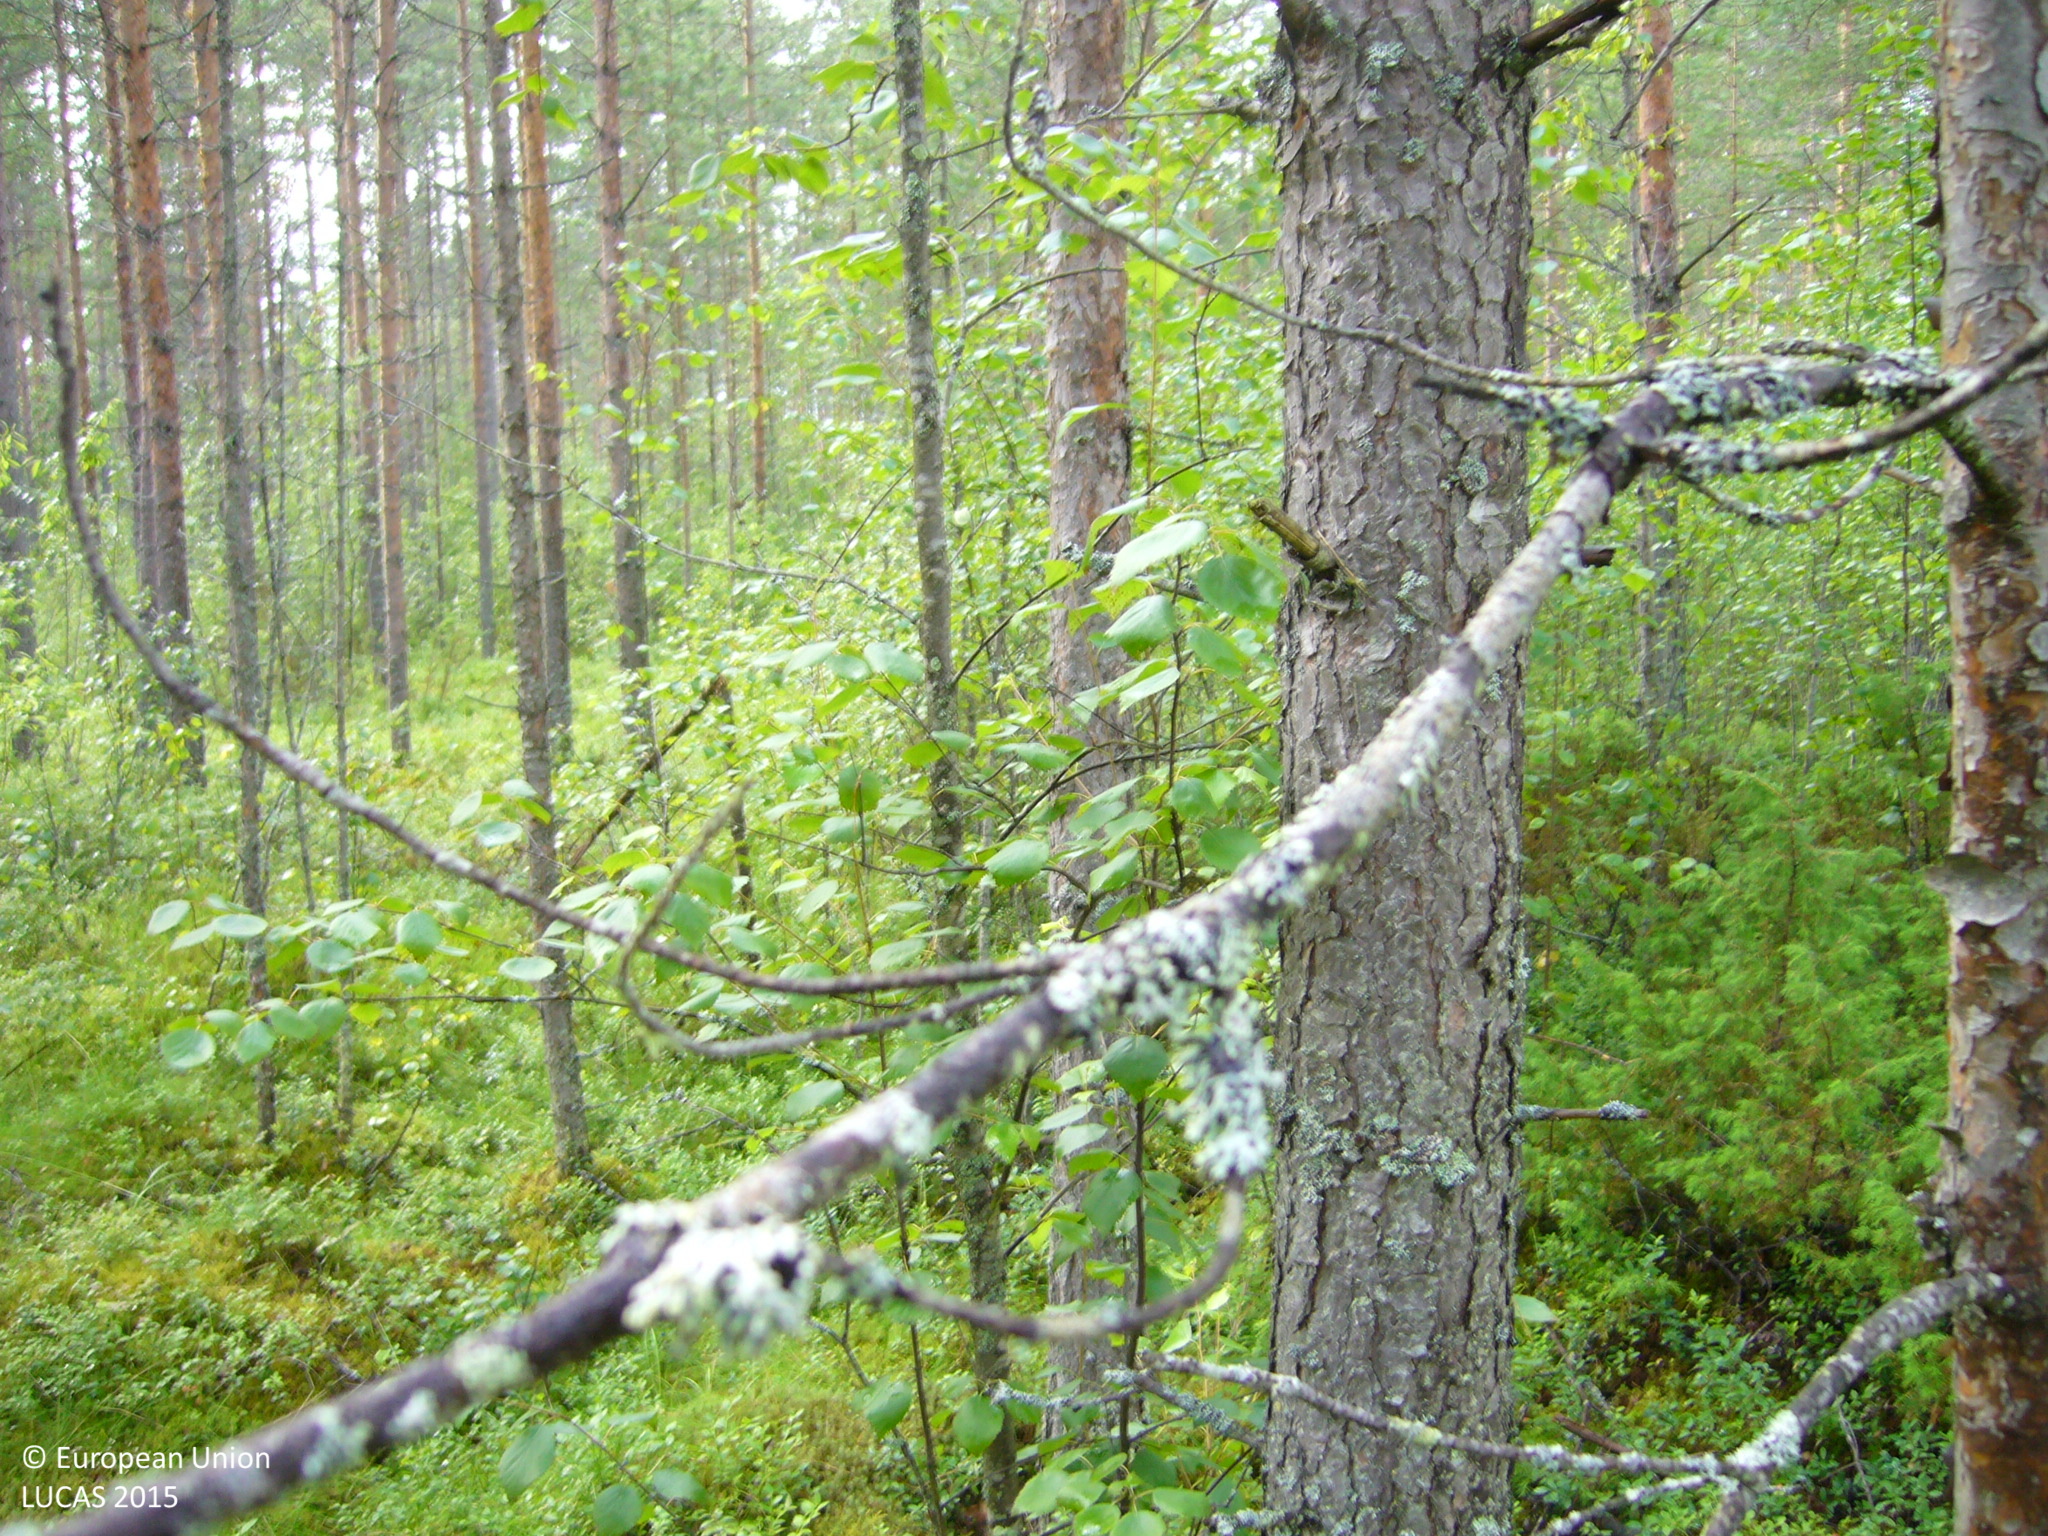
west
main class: Woodland
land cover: Pine dominated mixed woodland
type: boreal forest
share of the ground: > 75 %
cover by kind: coniferous forest trees 50 %, broadleaved forest trees 30 %, shrubs 20 %
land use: Forestry
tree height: > 5 m
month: July
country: FI
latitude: 63.9723
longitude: 25.7689
